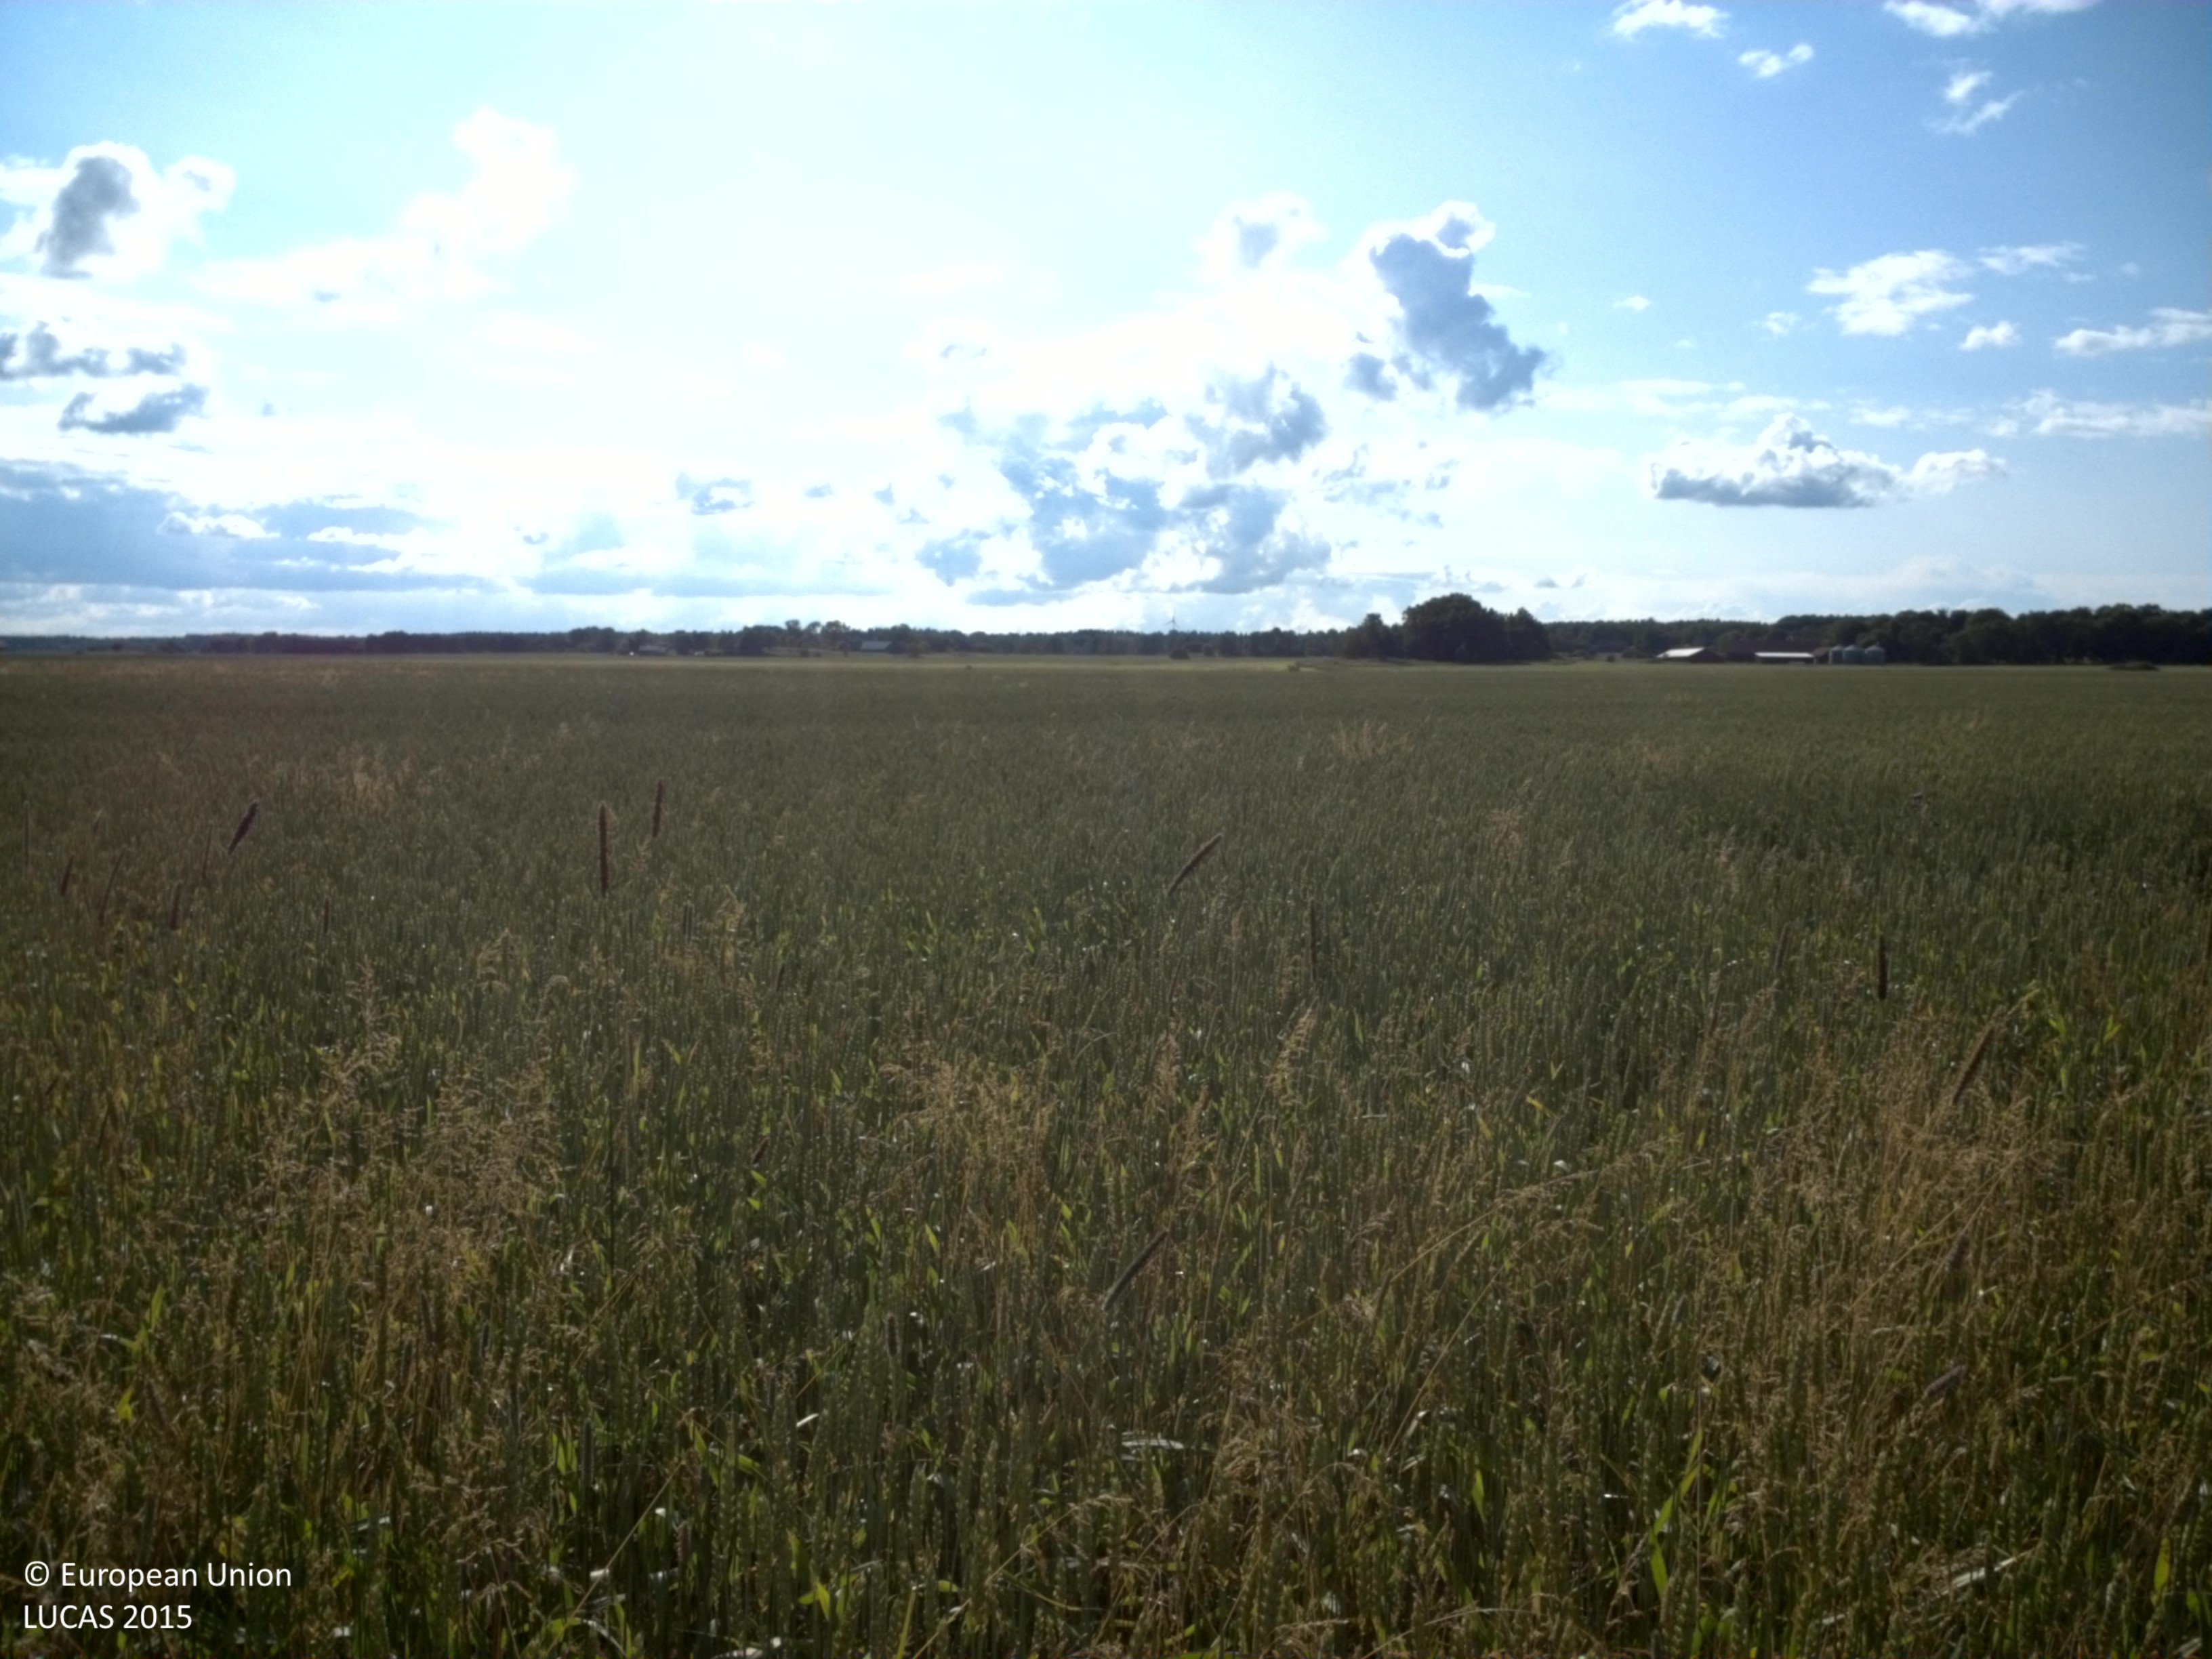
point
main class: Cropland
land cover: Common wheat
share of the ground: > 75 %
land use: Agriculture (excluding fallow land and kitchen gardens)
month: July
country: SE
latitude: 58.6102
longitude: 14.0040
